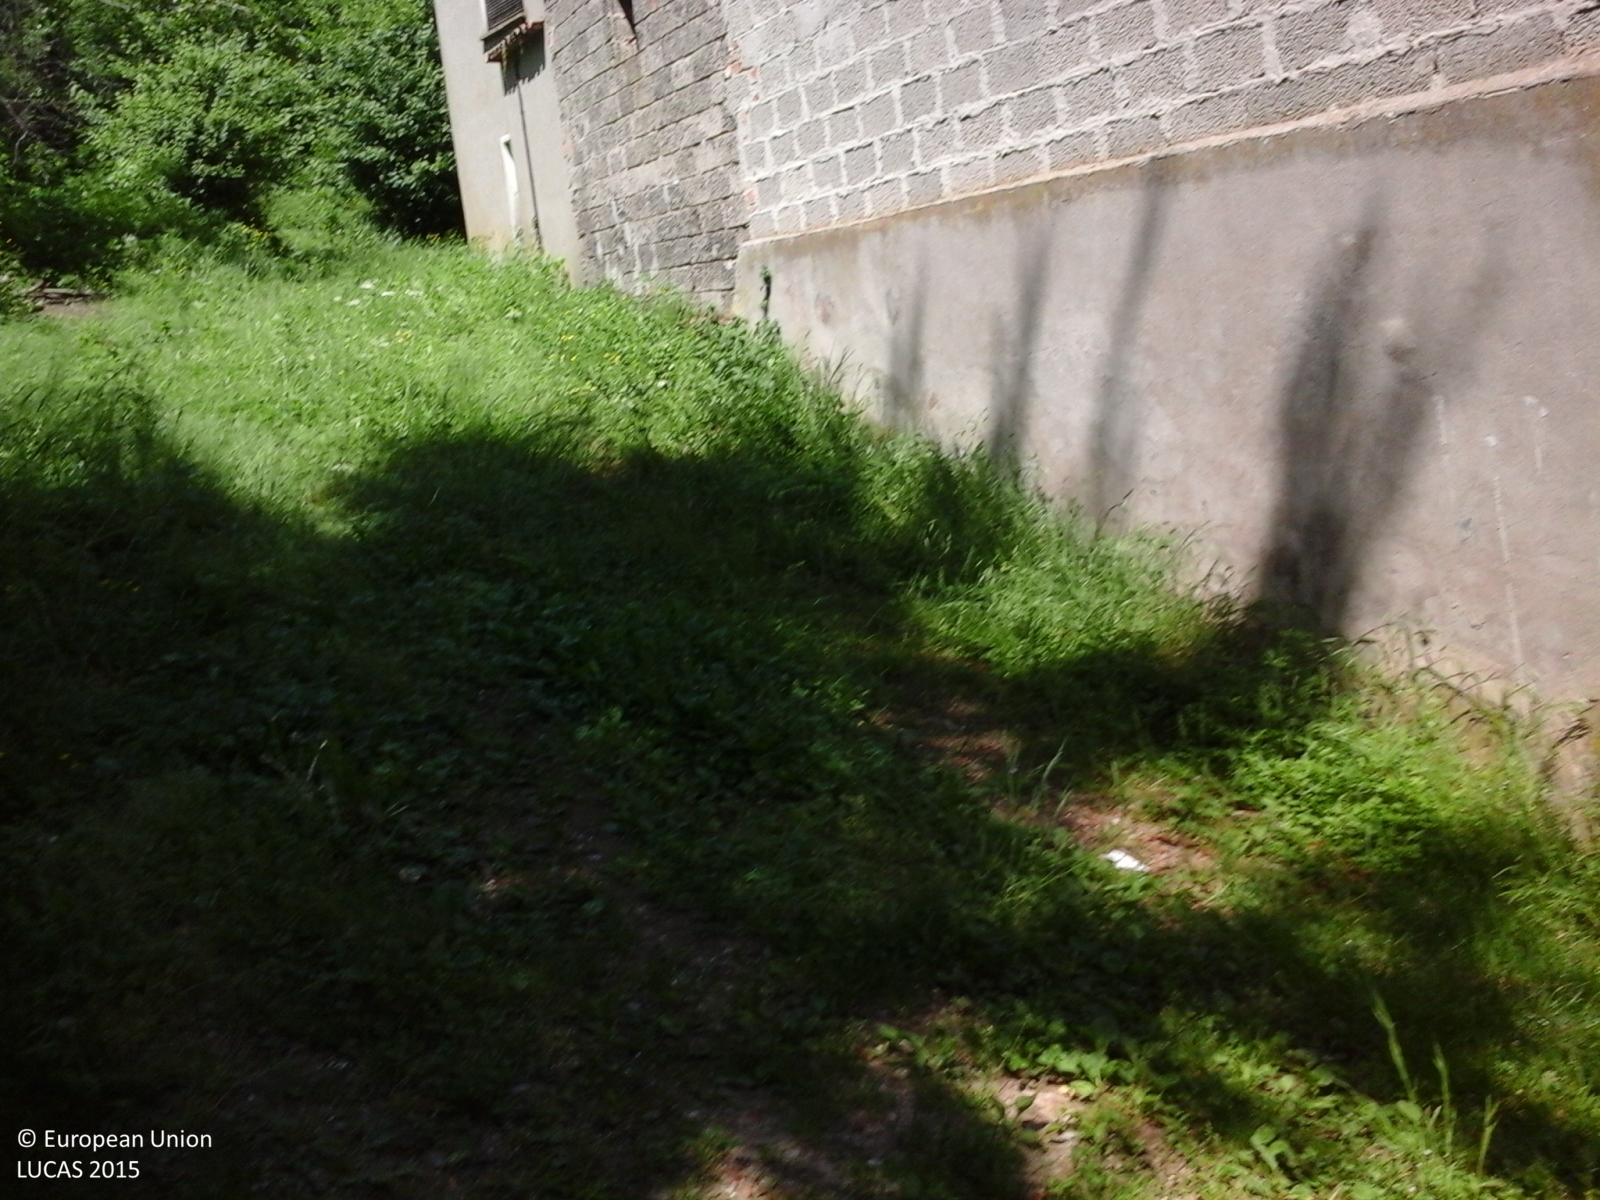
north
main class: Woodland
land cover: Broadleaved woodland
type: thermophilous deciduous forest
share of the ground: > 75 %
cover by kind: broadleaved forest trees 100 %
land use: Semi-natural and natural areas not in use
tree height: > 5 m
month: May
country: IT
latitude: 45.3102
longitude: 11.7189
